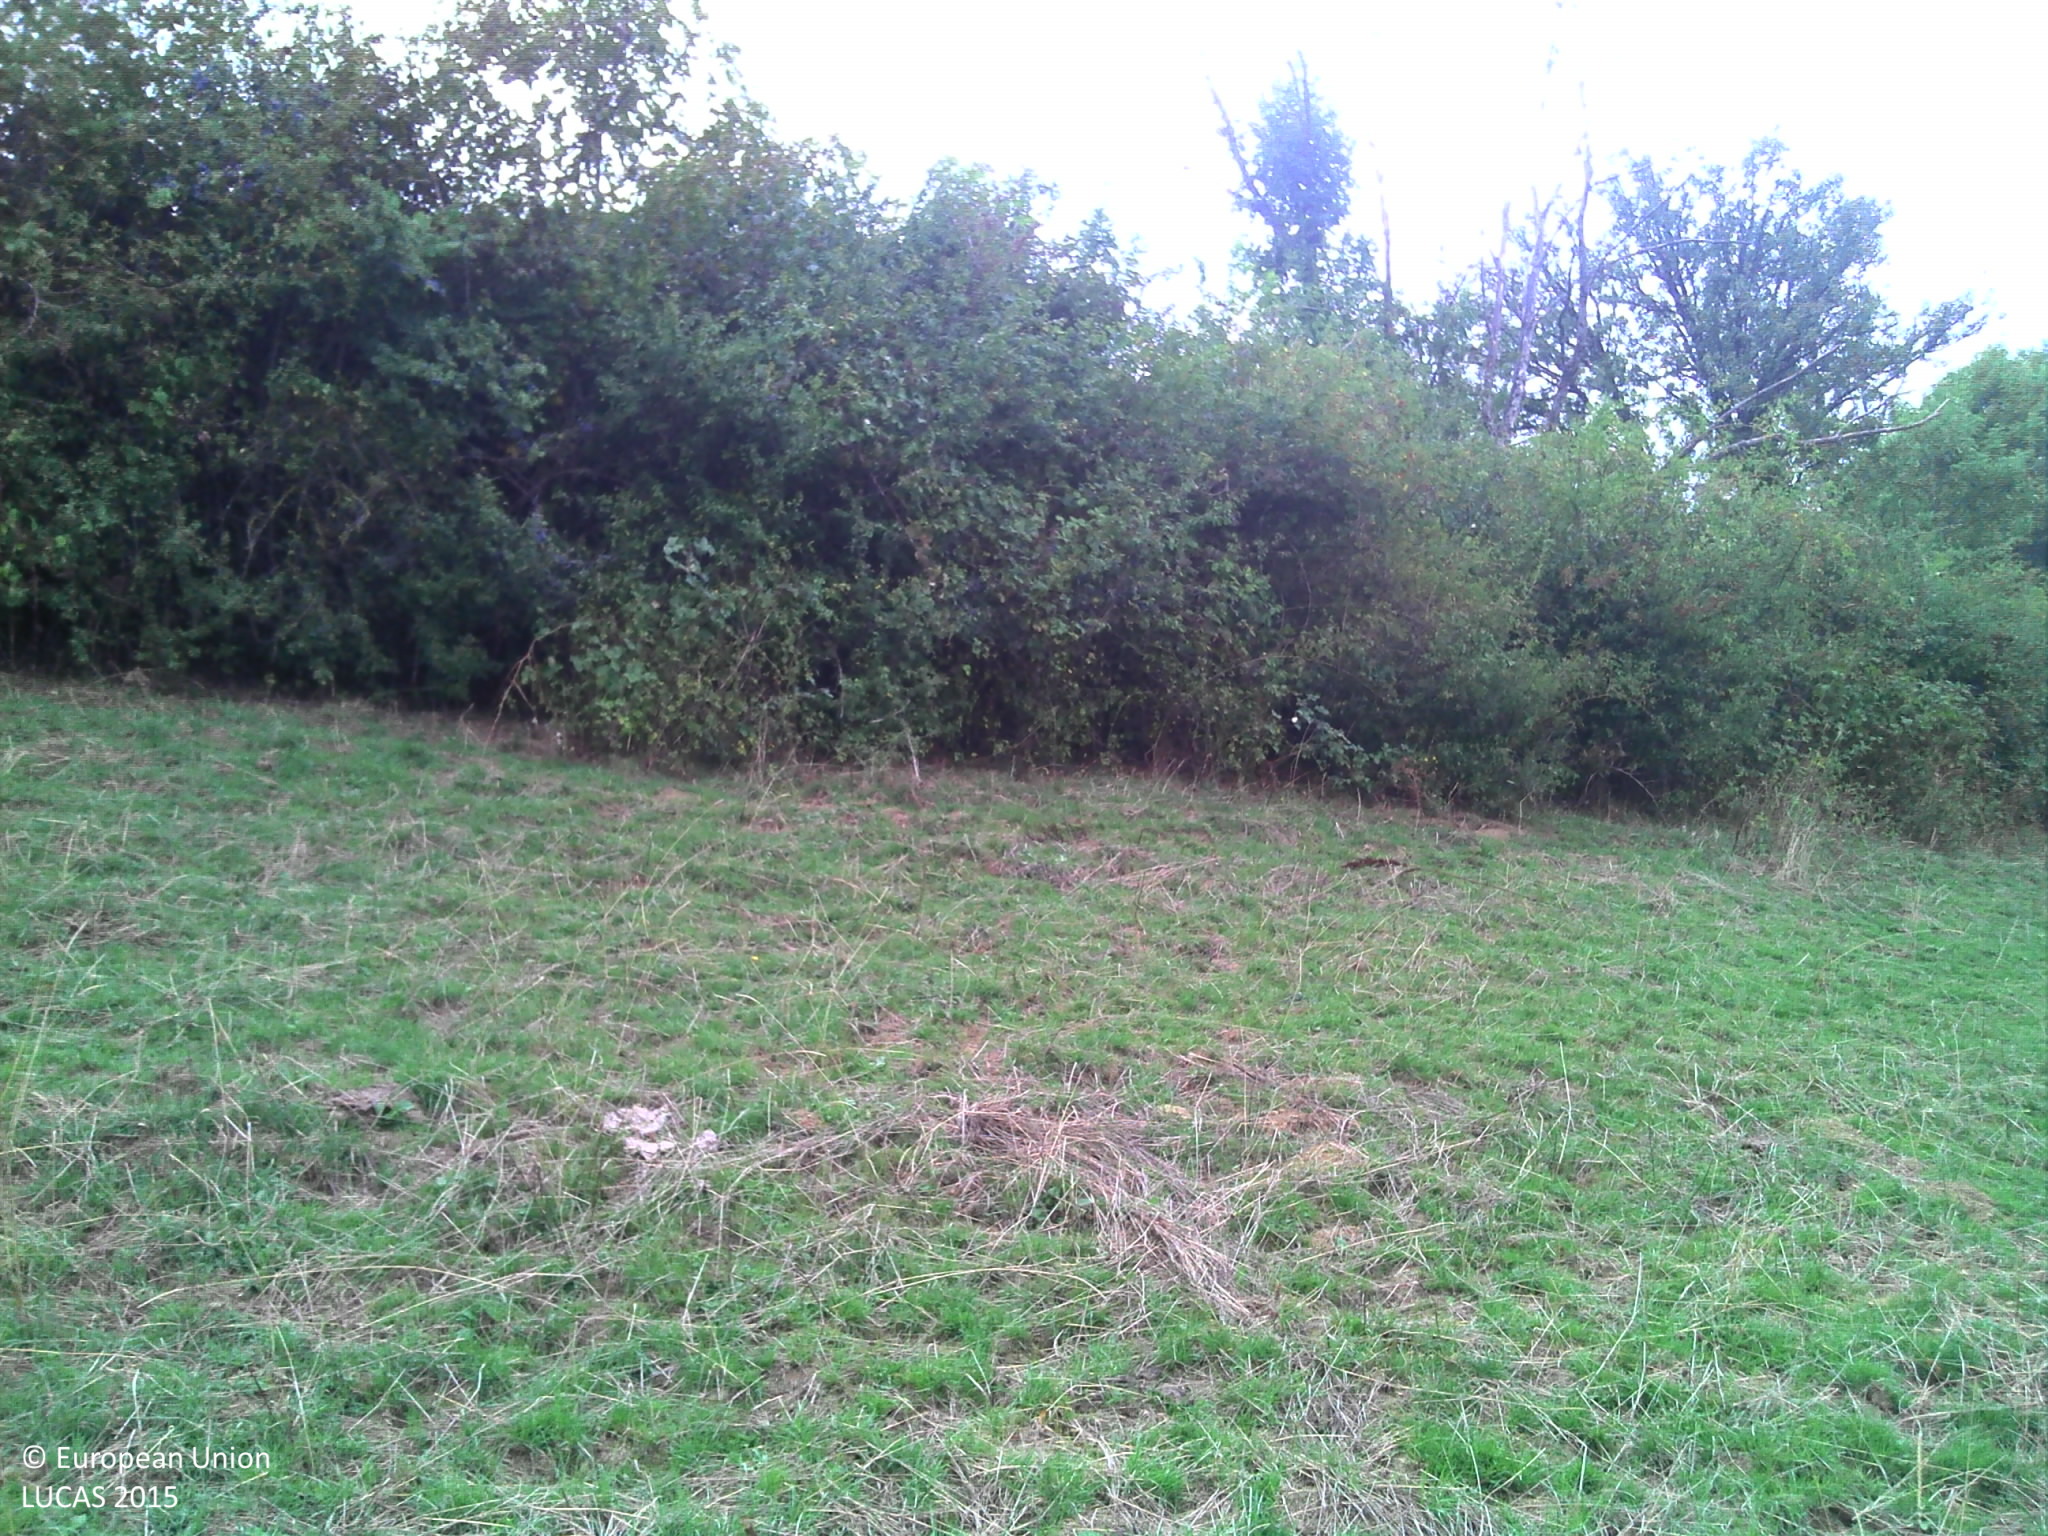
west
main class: Grassland
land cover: Grassland without tree/shrub cover
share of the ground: > 75 %
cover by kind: herbaceous plants 100 %
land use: Agriculture (excluding fallow land and kitchen gardens)
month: August
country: FR
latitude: 47.2664
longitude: 4.7000
